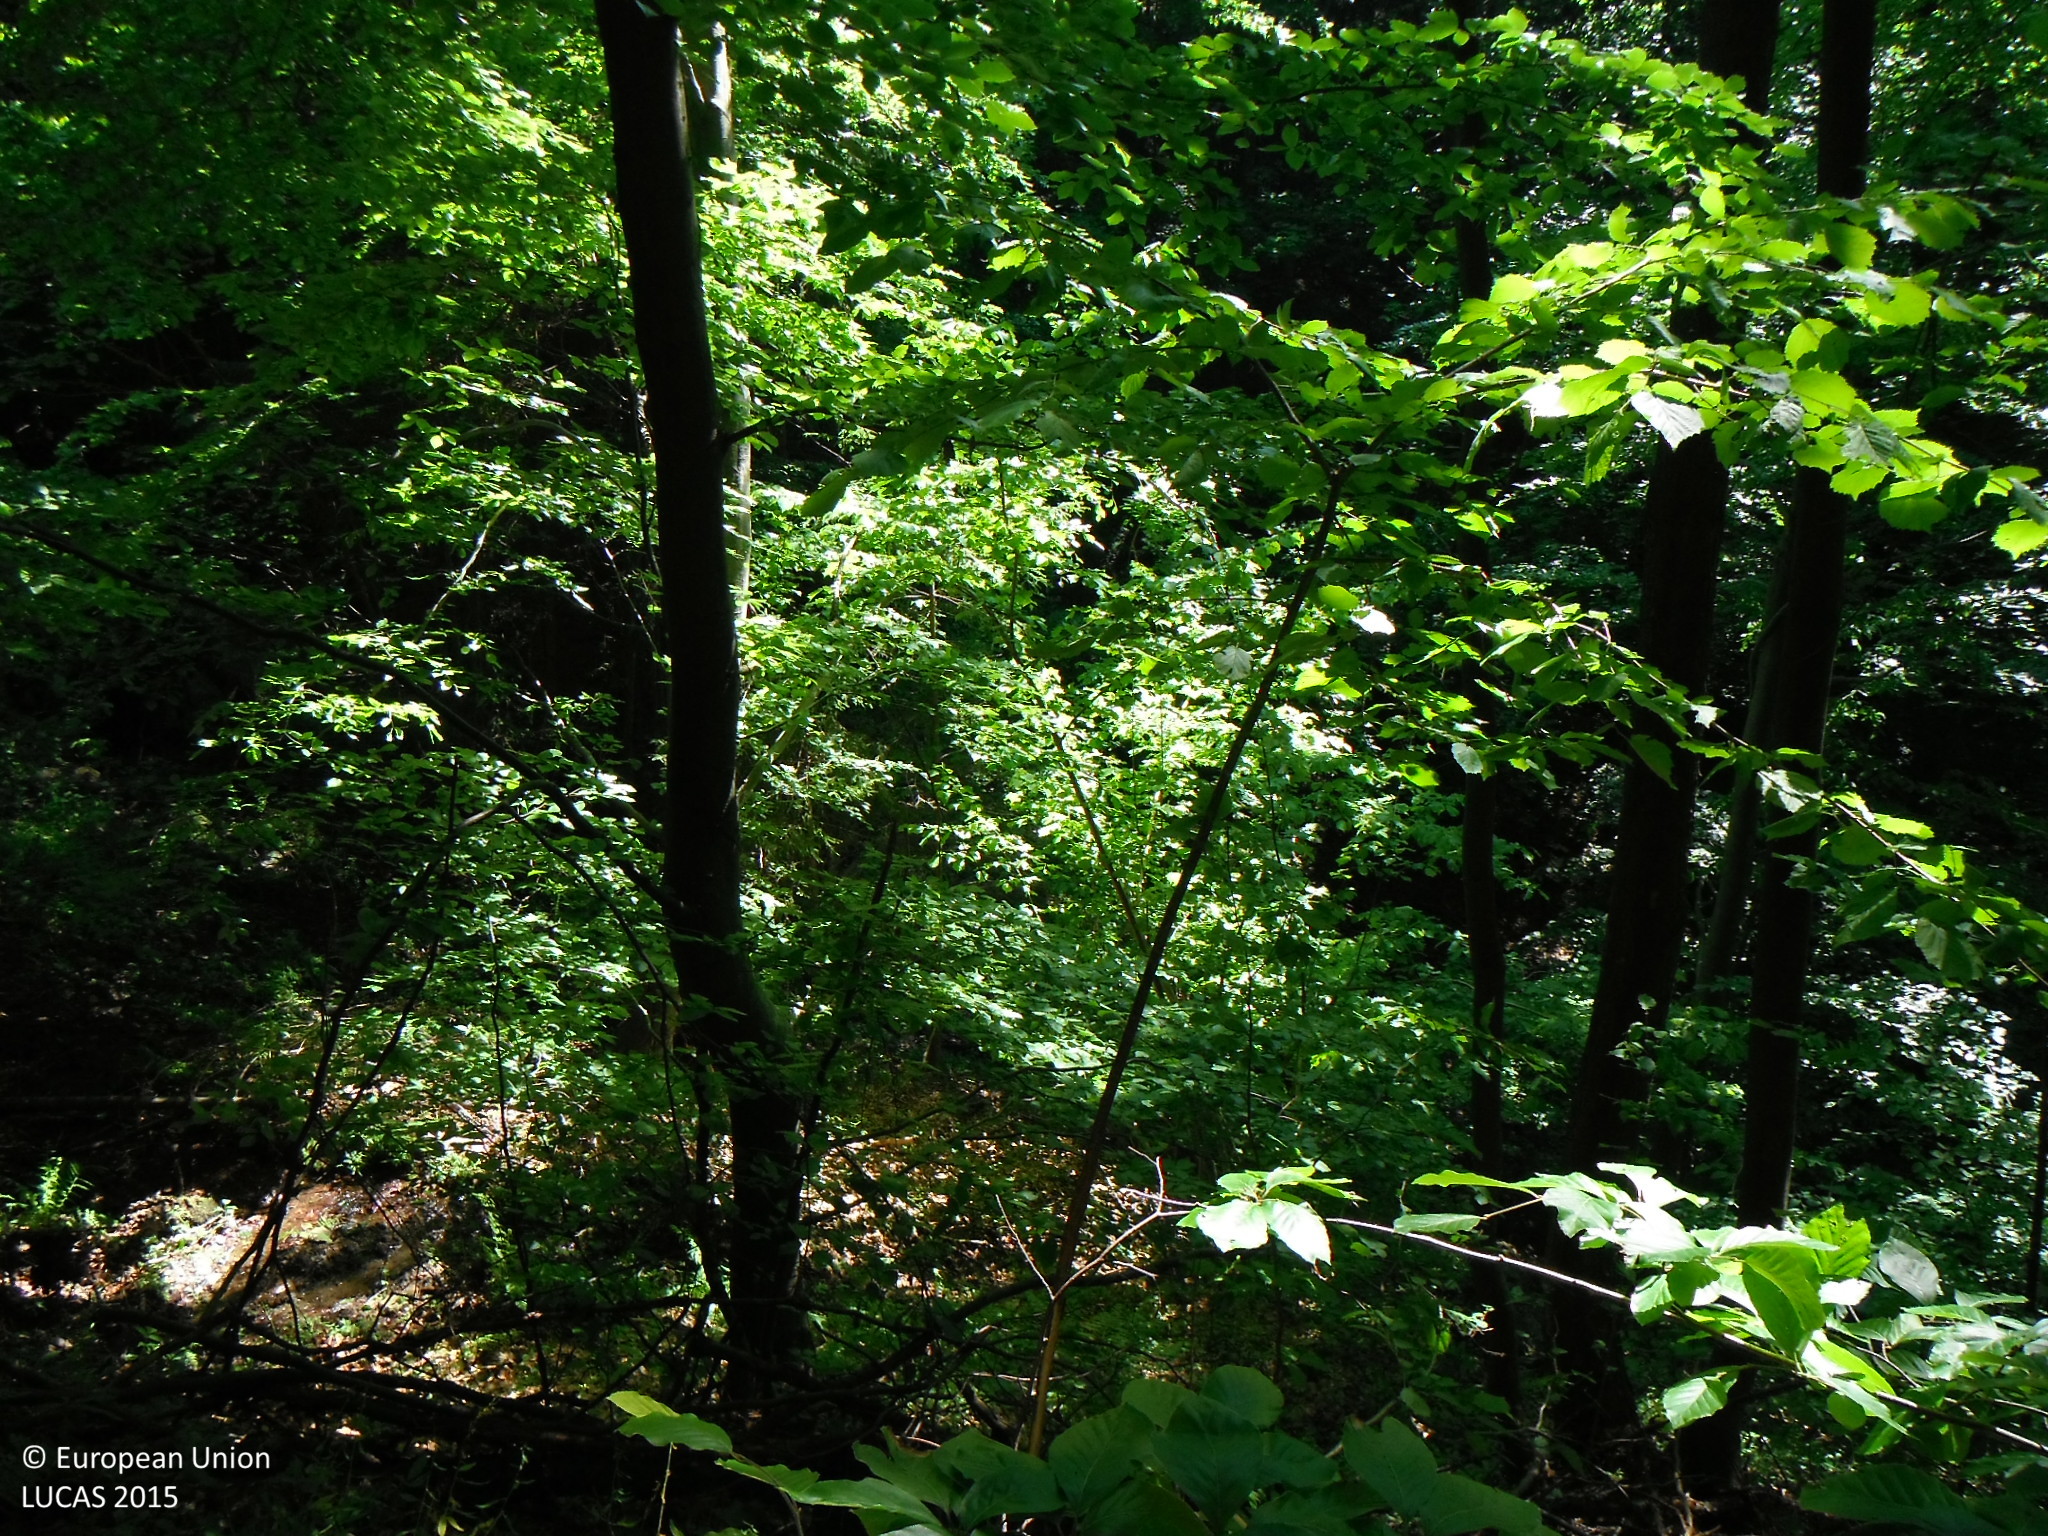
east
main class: Woodland
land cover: Broadleaved woodland
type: beech forest
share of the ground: > 75 %
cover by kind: broadleaved forest trees 95 %, herbaceous plants 5 %
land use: Forestry
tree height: > 5 m
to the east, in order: Broadleaved woodland; Rivers and streams; Broadleaved woodland; Tracks; Broadleaved woodland; Spruce dominated coniferous woodland; Tracks; Broadleaved woodland
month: May
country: SK
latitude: 48.5688
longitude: 19.5526
